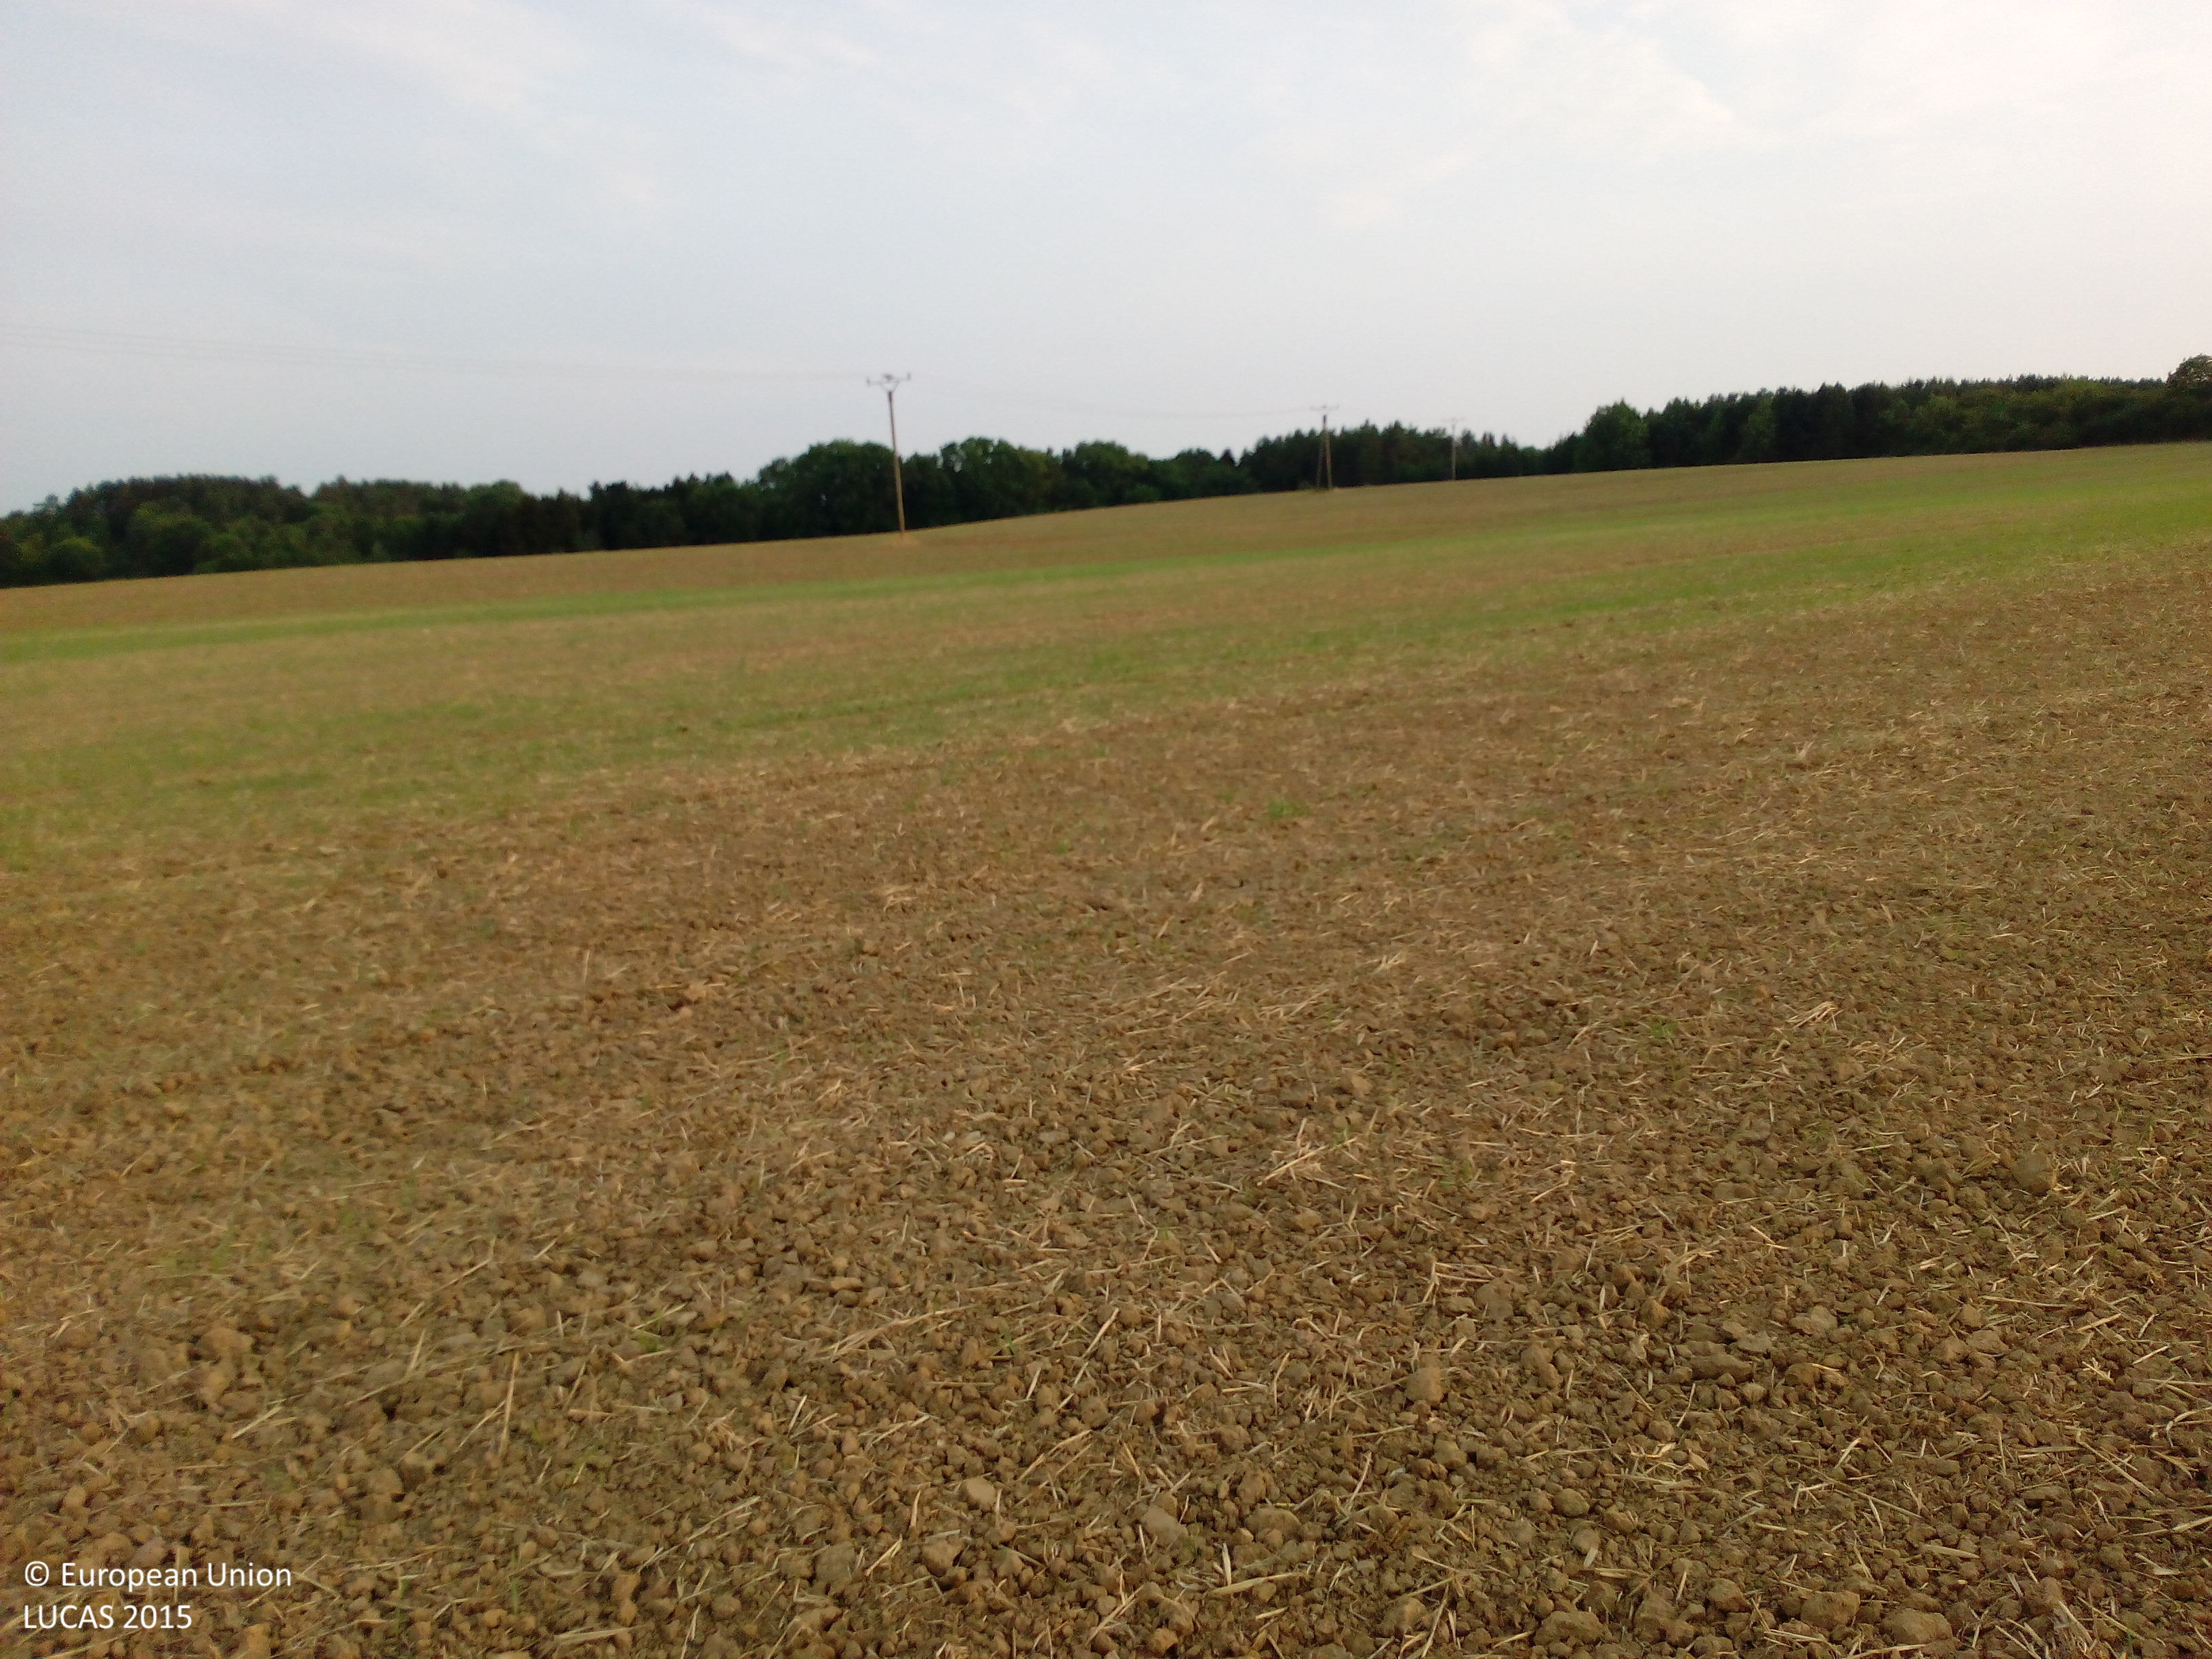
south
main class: Cropland
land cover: Common wheat
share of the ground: < 10 %
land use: Agriculture (excluding fallow land and kitchen gardens)
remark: Harvested field
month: August
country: DE
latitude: 51.2265
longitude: 10.3579
